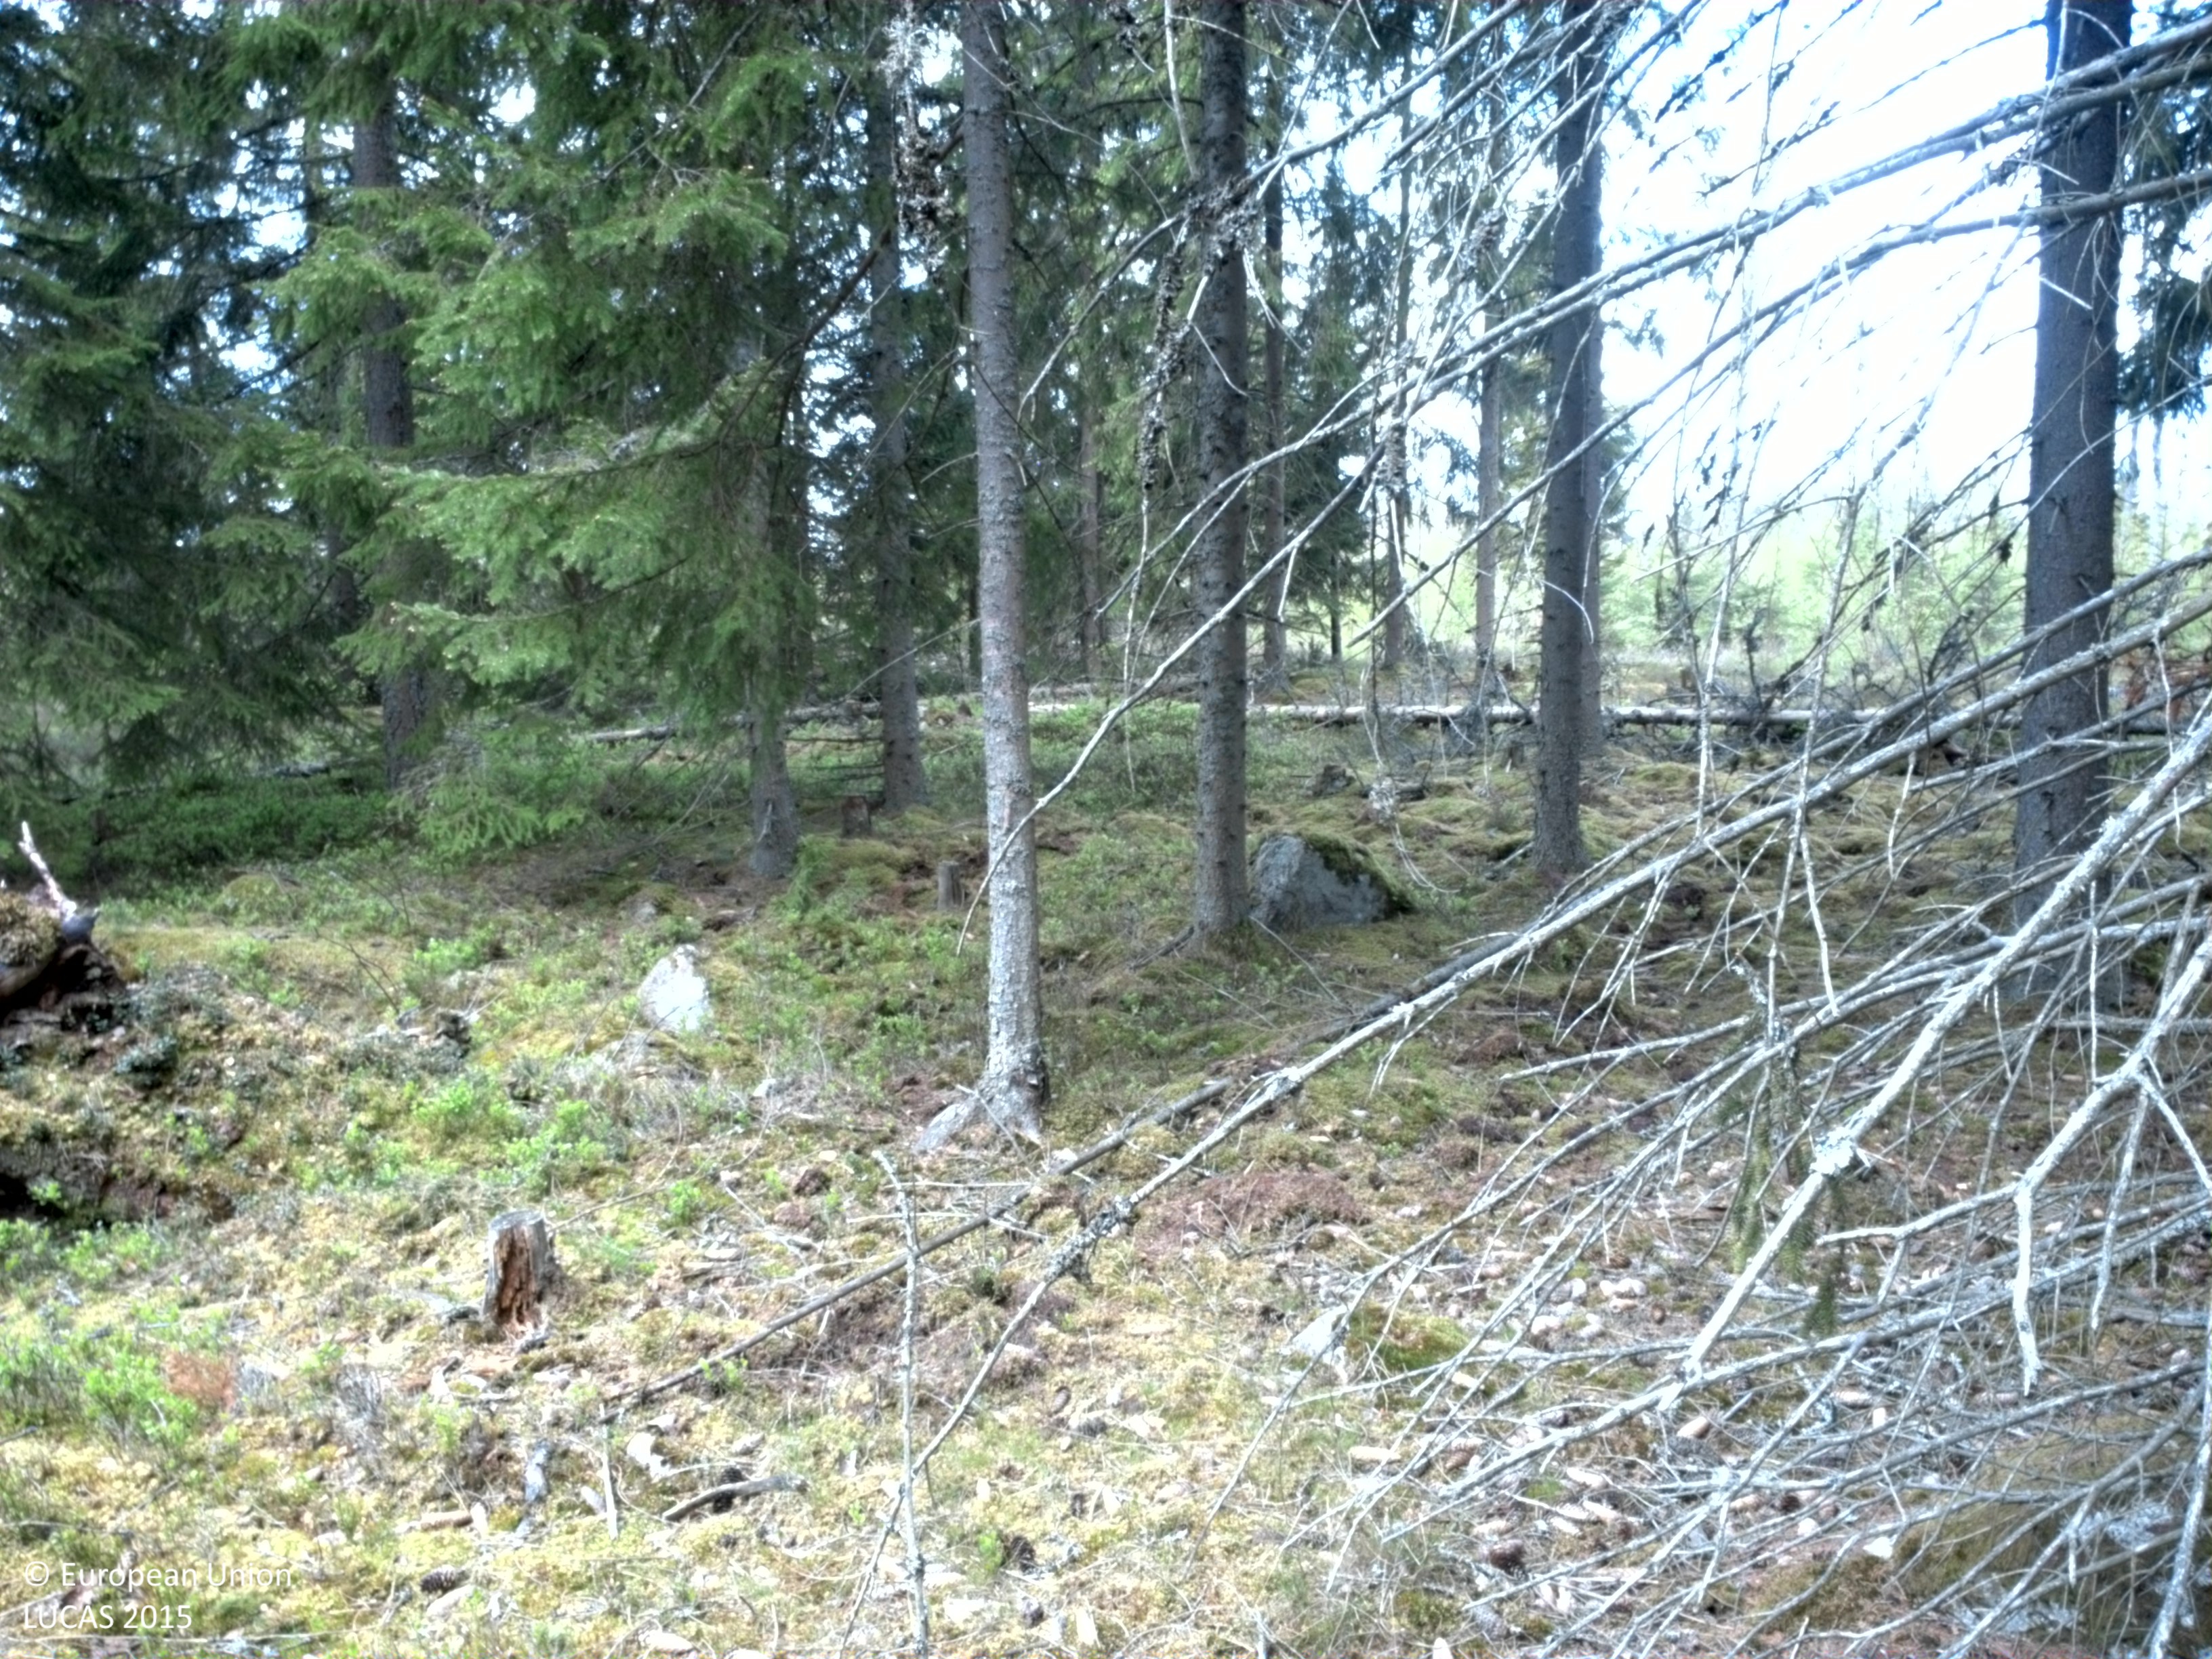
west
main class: Woodland
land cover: Spruce dominated coniferous woodland
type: boreal forest
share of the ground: 50 - 75 %
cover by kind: coniferous forest trees 60 %, shrubs 15 %, lichens and mosses 15 %, broadleaved forest trees 10 %
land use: Forestry
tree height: > 5 m
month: May
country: SE
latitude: 56.7818
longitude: 15.2845
